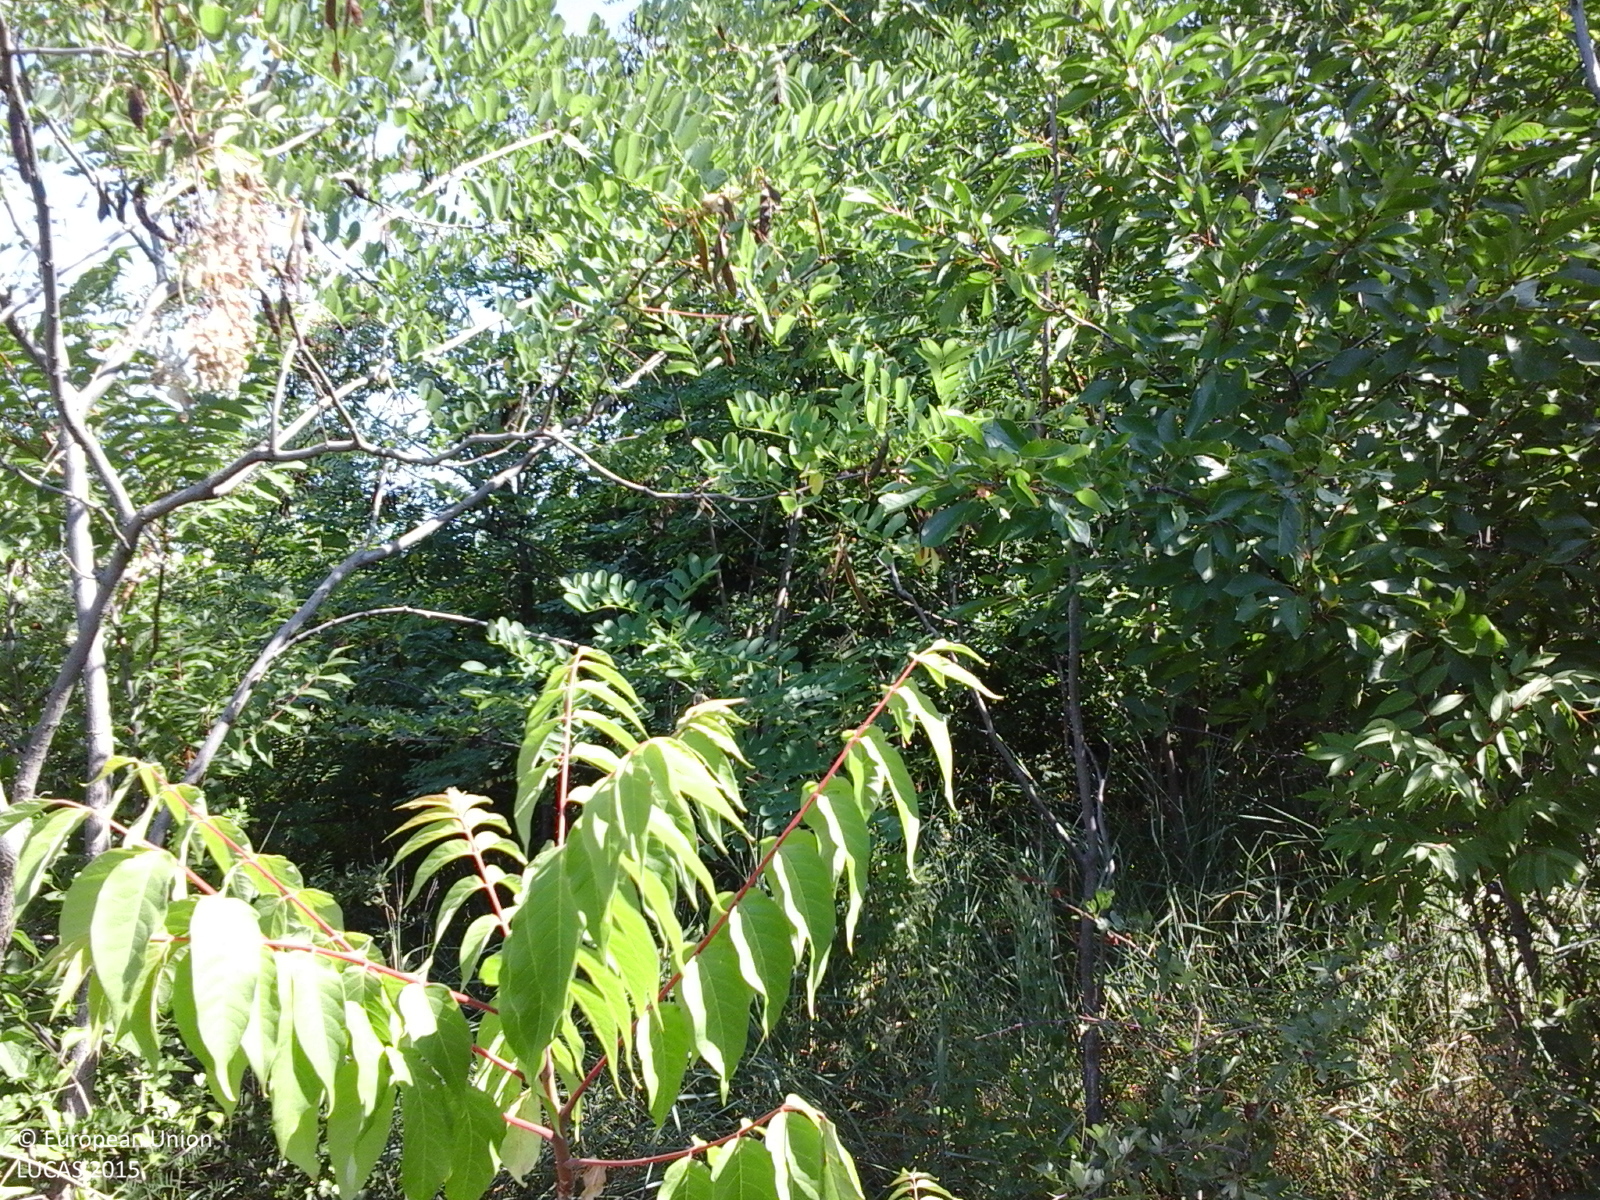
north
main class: Grassland
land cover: Grassland with sparse tree/shrub cover
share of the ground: > 75 %
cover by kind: herbaceous plants 90 %, broadleaved forest trees 5 %, shrubs 5 %
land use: Agriculture (excluding fallow land and kitchen gardens)
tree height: > 5 m
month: June
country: RO
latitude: 47.1311
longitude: 27.6679
